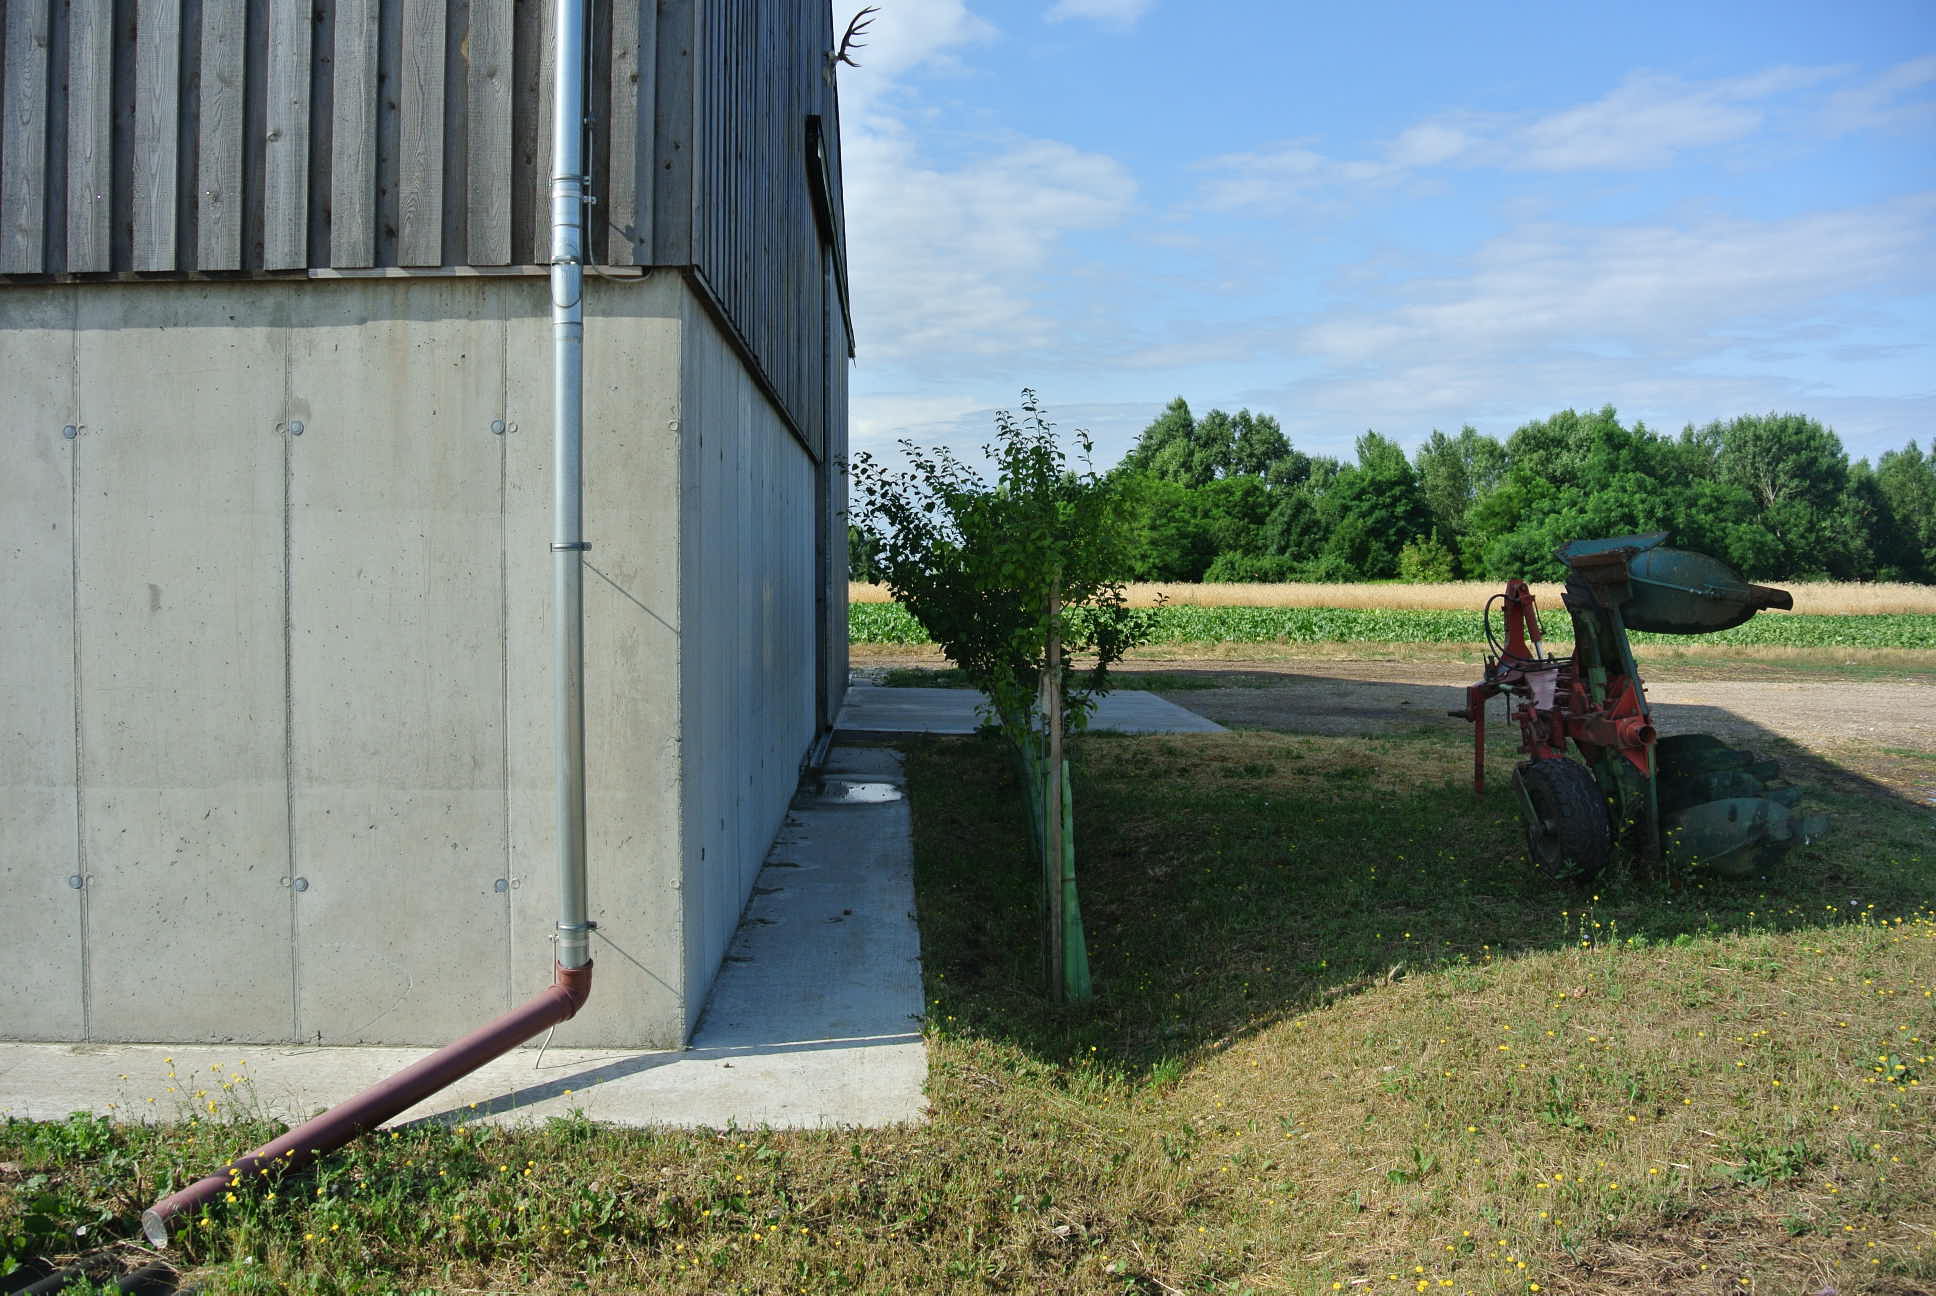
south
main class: Cropland
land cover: Mixed cereals for fodder
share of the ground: > 75 %
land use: Agriculture (excluding fallow land and kitchen gardens)
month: July
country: AT
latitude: 48.0100
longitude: 16.8565
